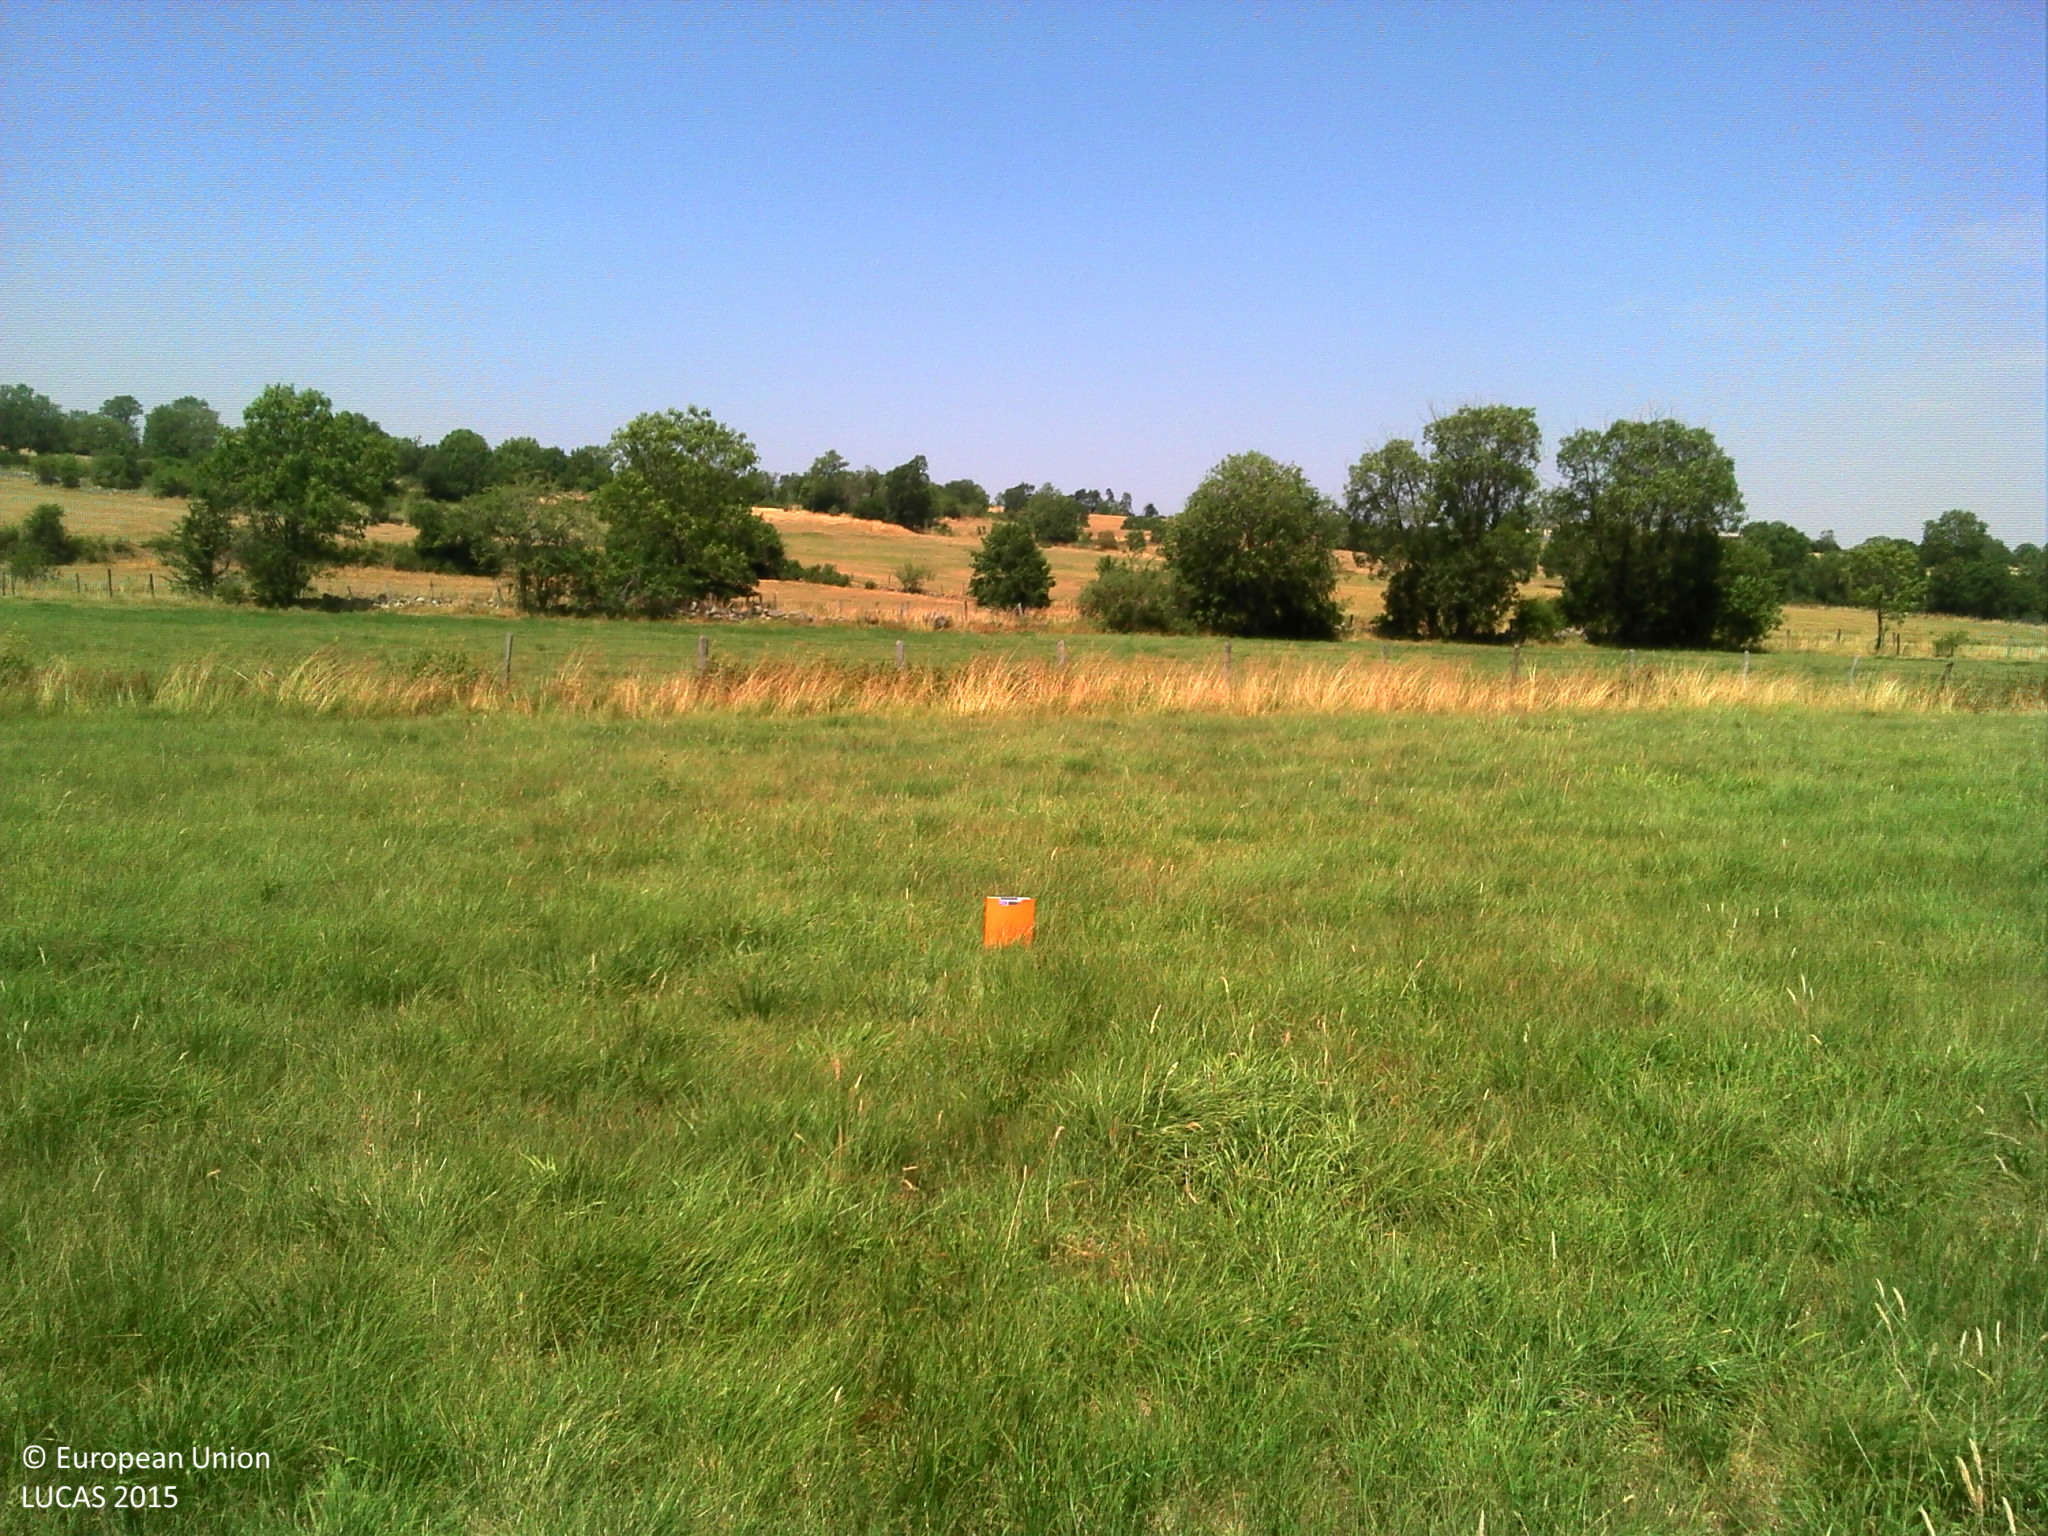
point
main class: Grassland
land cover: Grassland without tree/shrub cover
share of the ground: > 75 %
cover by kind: herbaceous plants 100 %
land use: Agriculture (excluding fallow land and kitchen gardens)
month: July
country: FR
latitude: 45.0681
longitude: 2.9272
